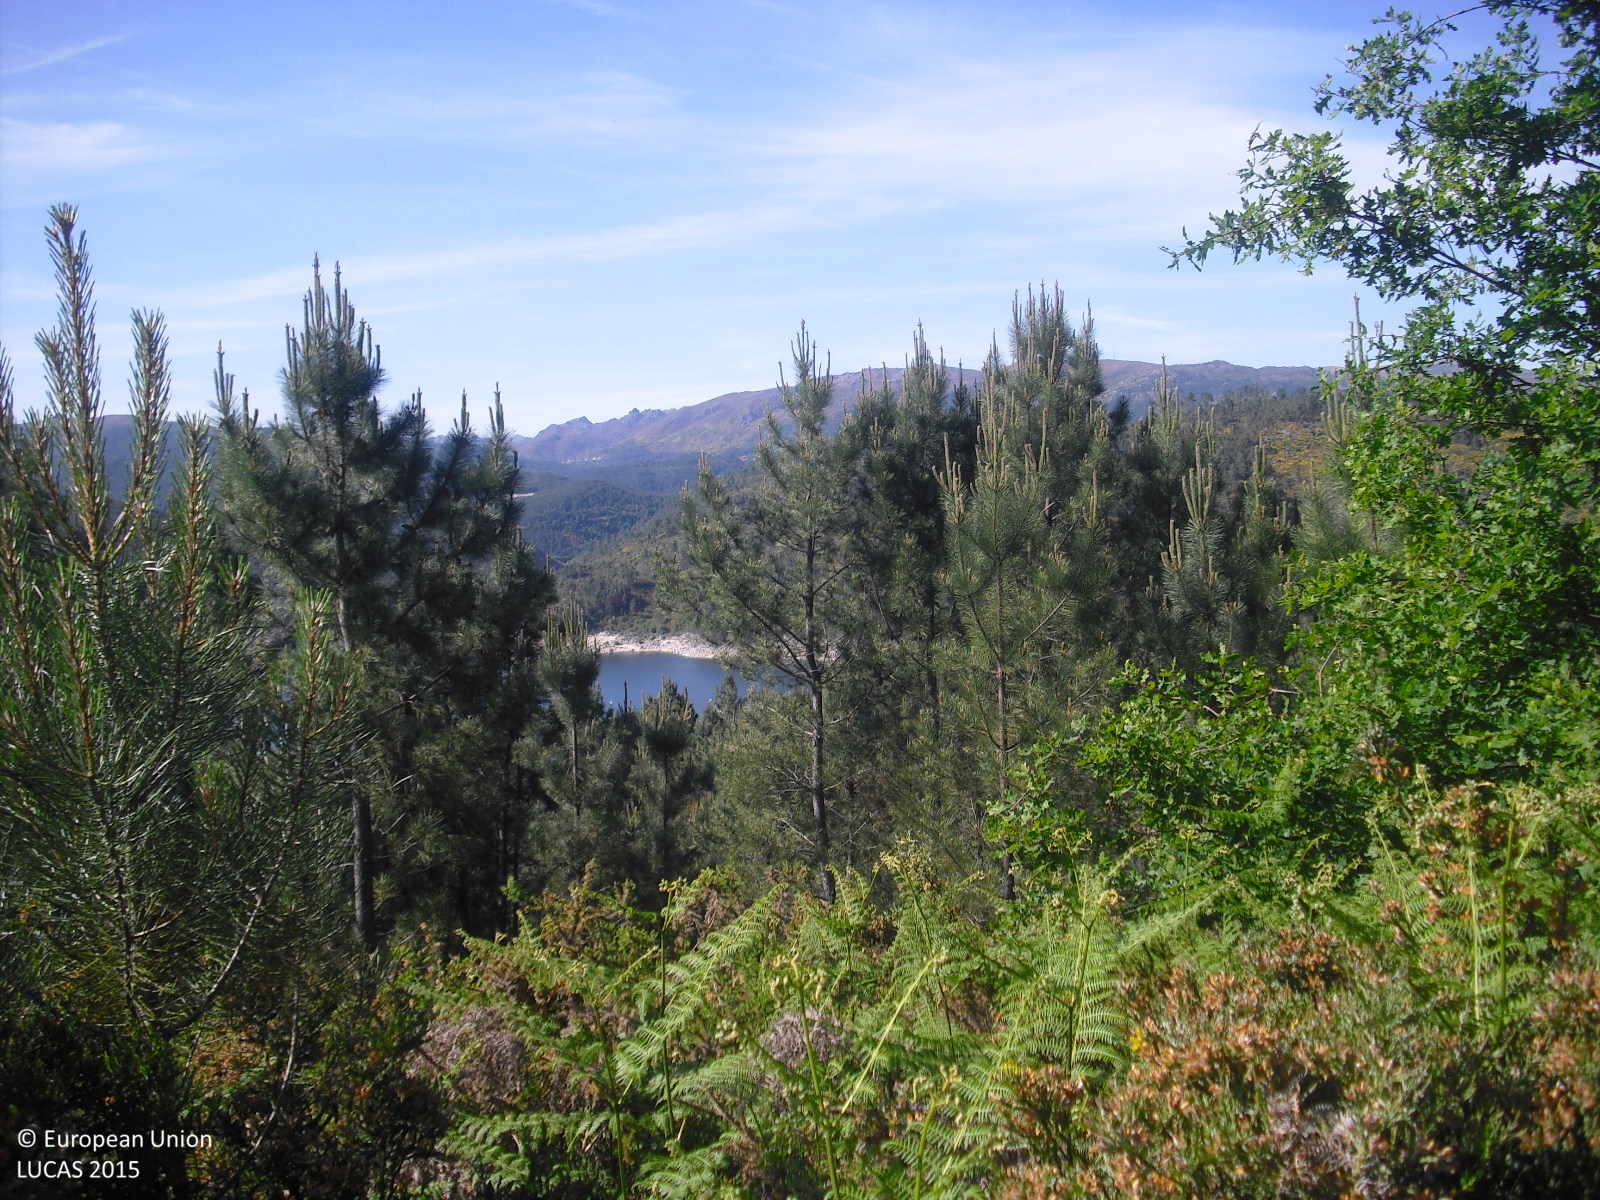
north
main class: Shrubland
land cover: Shrubland with sparse tree cover
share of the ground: > 75 %
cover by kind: shrubs 95 %, coniferous forest trees 5 %
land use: Forestry
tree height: < 5 m
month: May
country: ES
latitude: 41.8897
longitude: -8.1199
